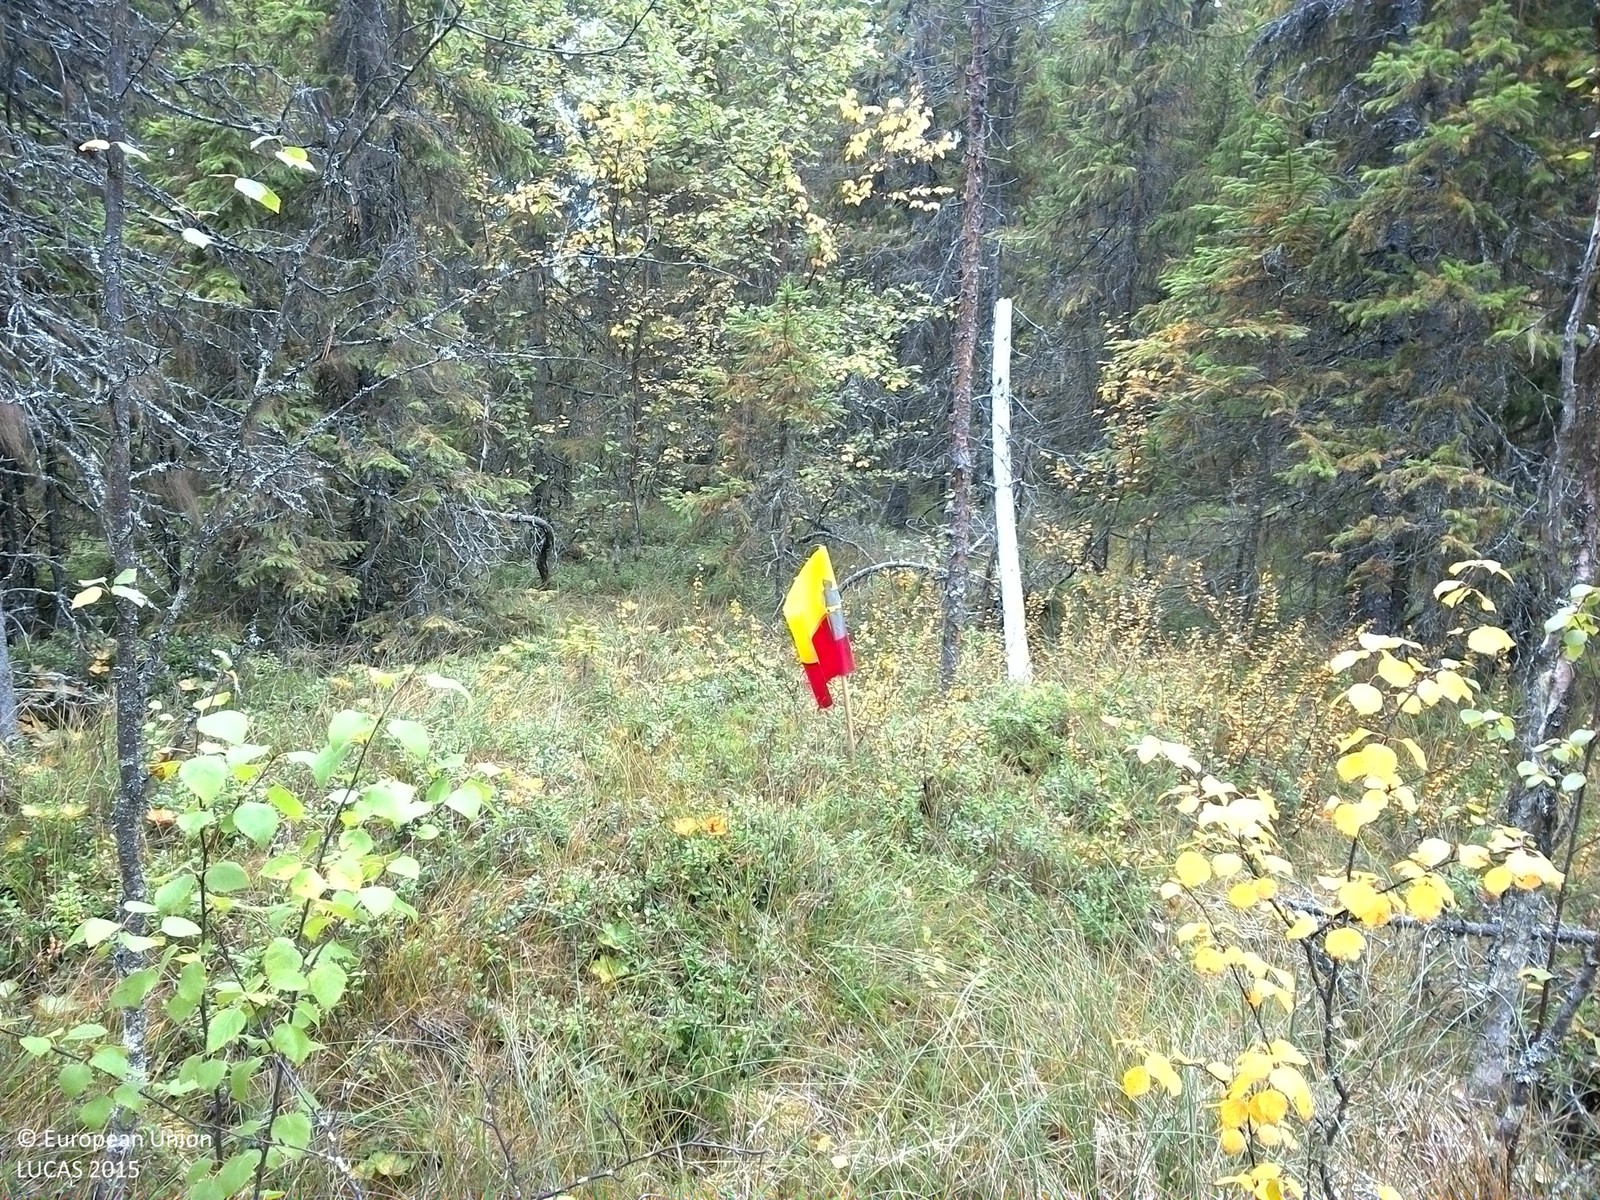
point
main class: Woodland
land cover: Spruce dominated coniferous woodland
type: boreal forest
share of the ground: 50 - 75 %
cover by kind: coniferous forest trees 55 %, shrubs 20 %, broadleaved forest trees 15 %, lichens and mosses 10 %
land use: Forestry
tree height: > 5 m
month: September
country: SE
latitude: 63.8874
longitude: 16.4270
